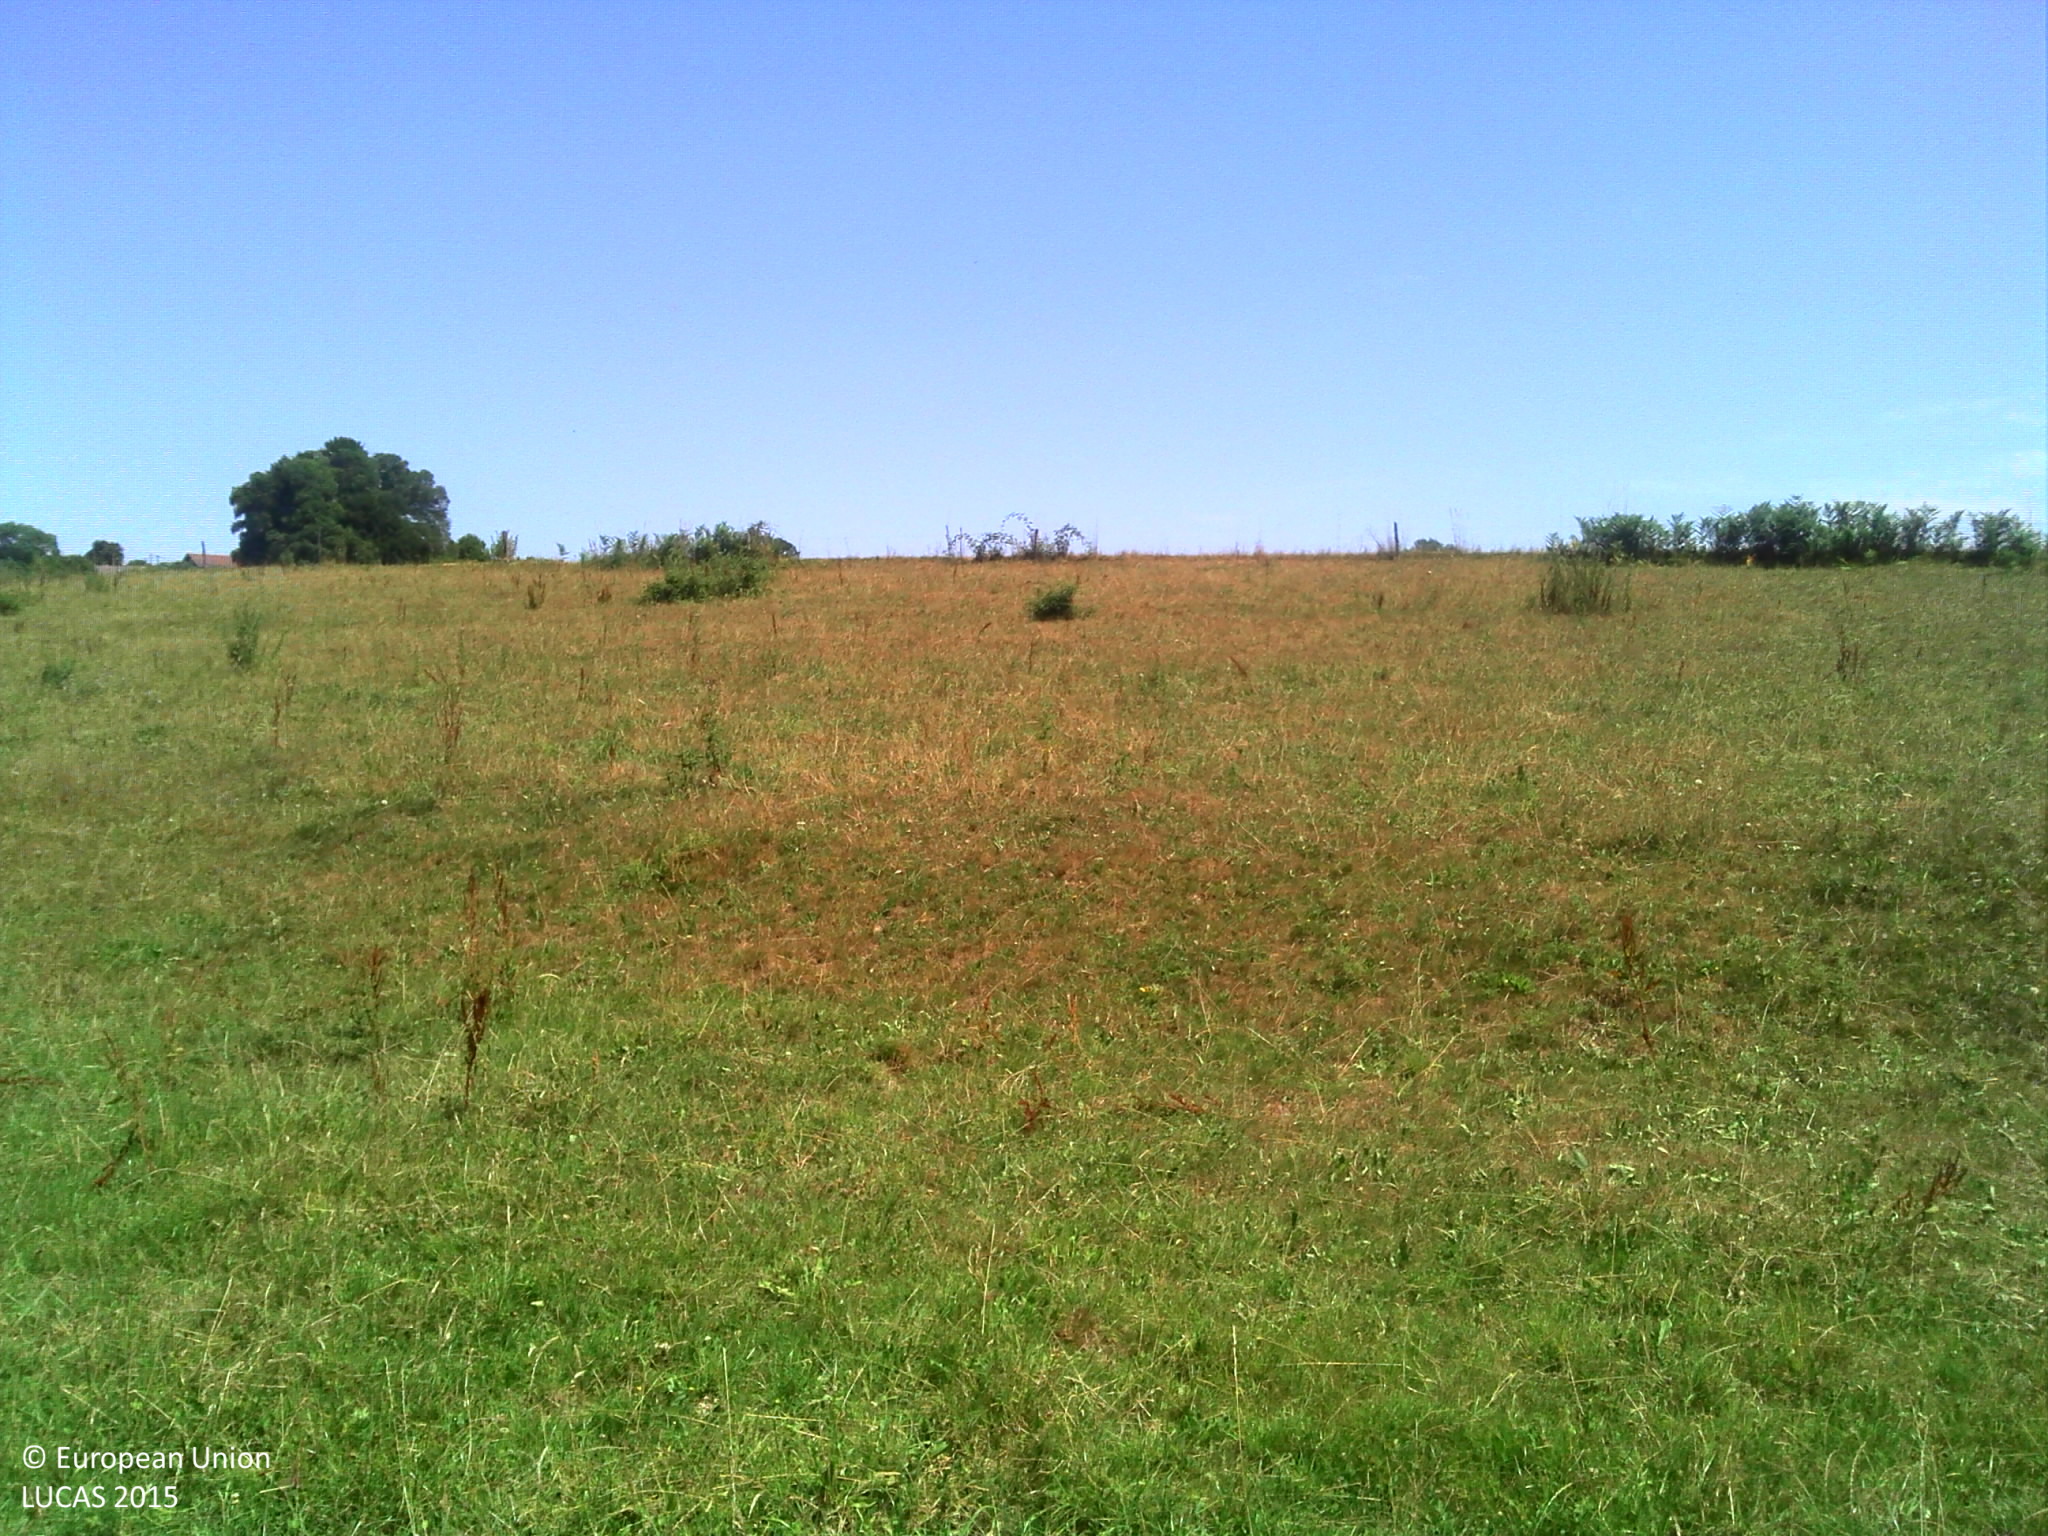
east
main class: Grassland
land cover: Grassland without tree/shrub cover
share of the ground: > 75 %
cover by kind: herbaceous plants 95 %, shrubs 5 %
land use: Agriculture (excluding fallow land and kitchen gardens)
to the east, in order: Fences; Grassland without tree/shrub cover; Fences; Common wheat; Electric lines; Common wheat
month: July
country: FR
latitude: 46.1084
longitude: 1.5691
